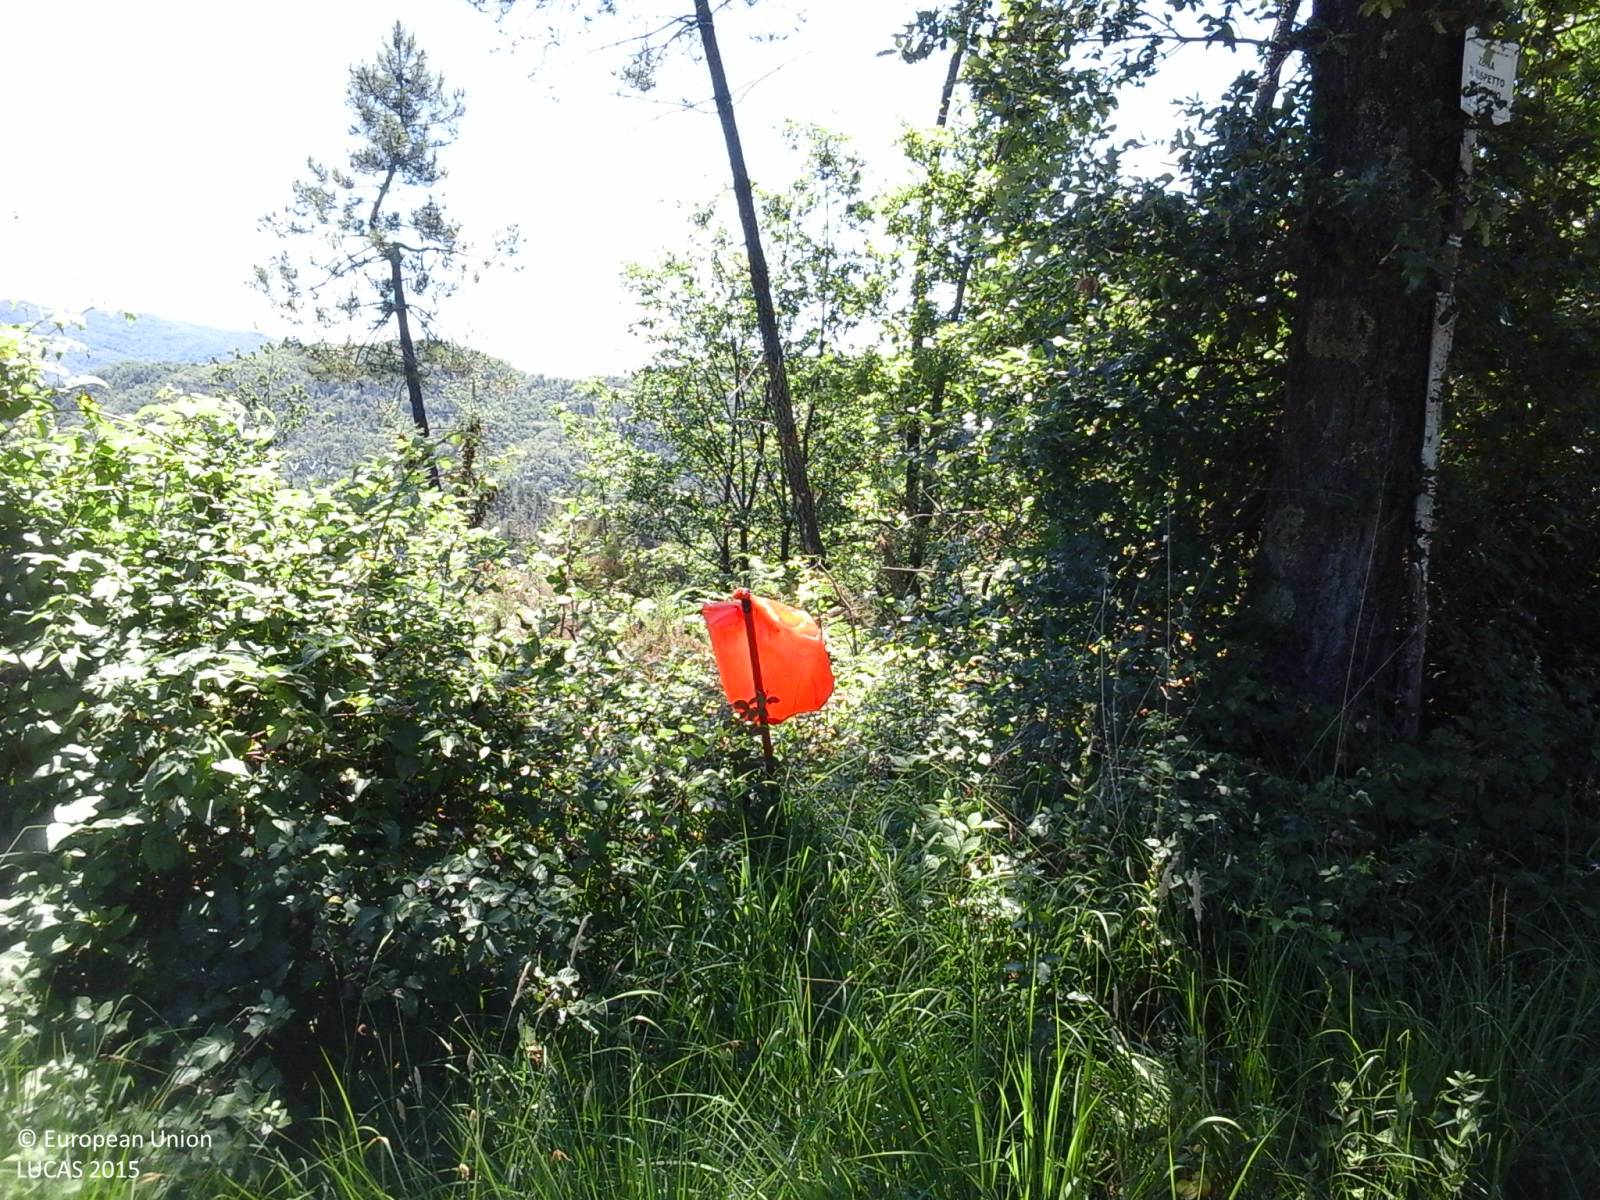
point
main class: Woodland
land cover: Broadleaved woodland
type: thermophilous deciduous forest
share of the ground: > 75 %
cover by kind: broadleaved forest trees 80 %, coniferous forest trees 10 %, shrubs 10 %
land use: Semi-natural and natural areas not in use
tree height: > 5 m
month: June
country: IT
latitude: 44.2062
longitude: 9.9126
